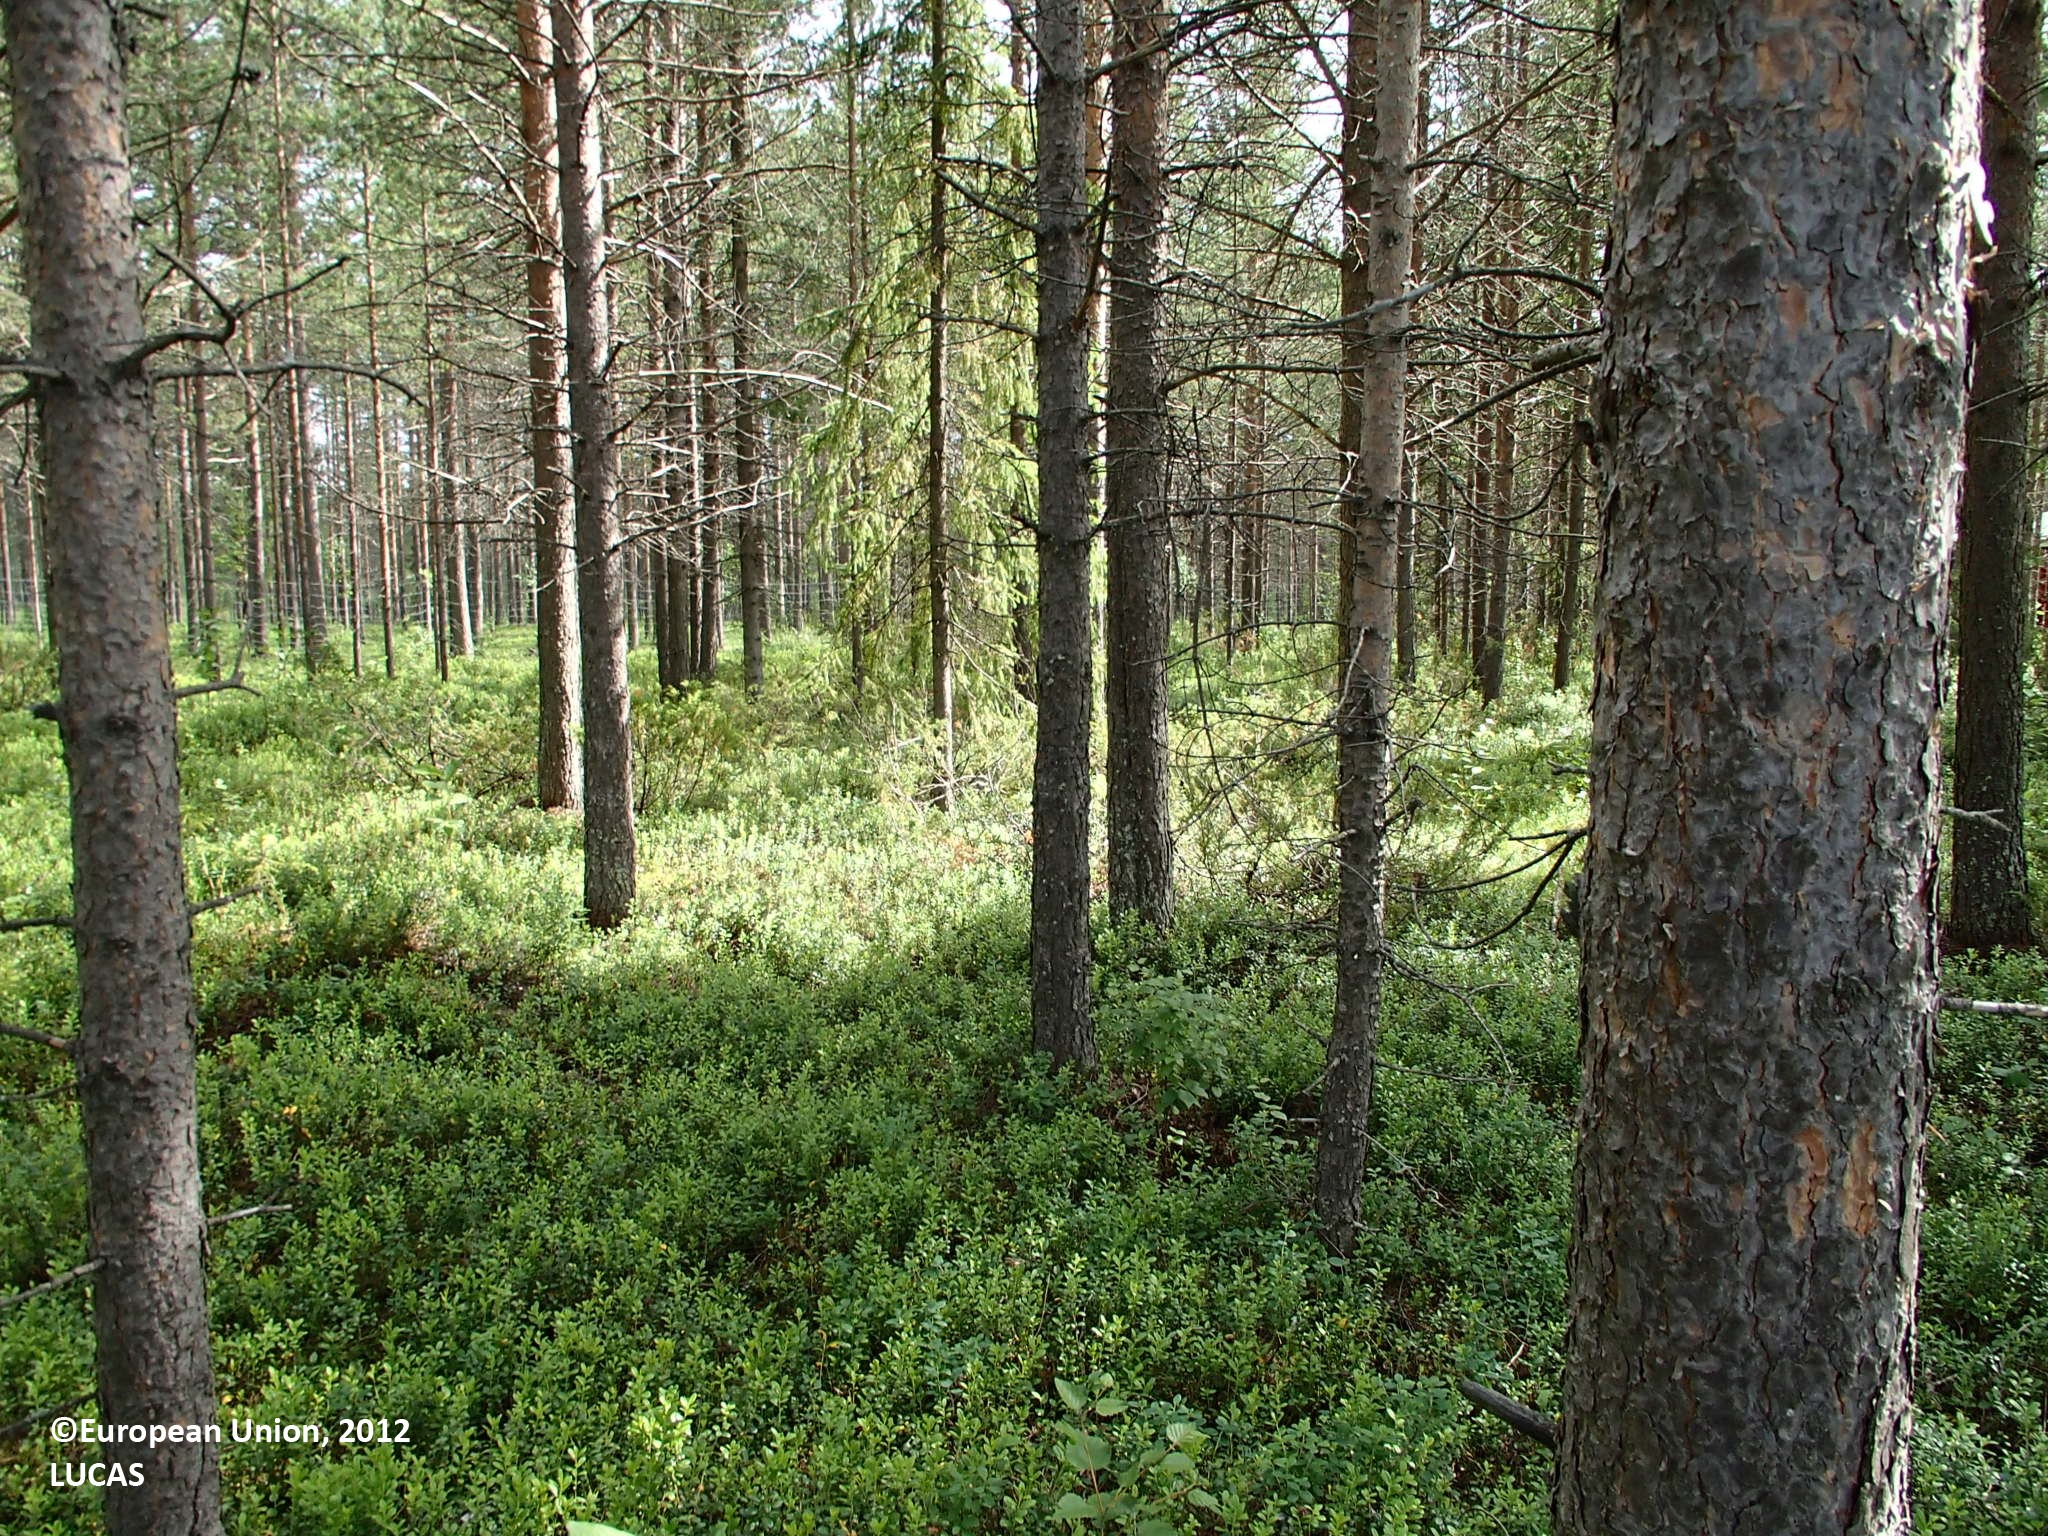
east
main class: Woodland
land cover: Pine dominated coniferous woodland
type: boreal forest
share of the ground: > 75 %
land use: Forestry
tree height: > 5 m
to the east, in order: Pine dominated coniferous woodland; Fences; Pine dominated coniferous woodland; Peatbogs; Pine dominated coniferous woodland
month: July
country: FI
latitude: 67.2762
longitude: 25.5262
